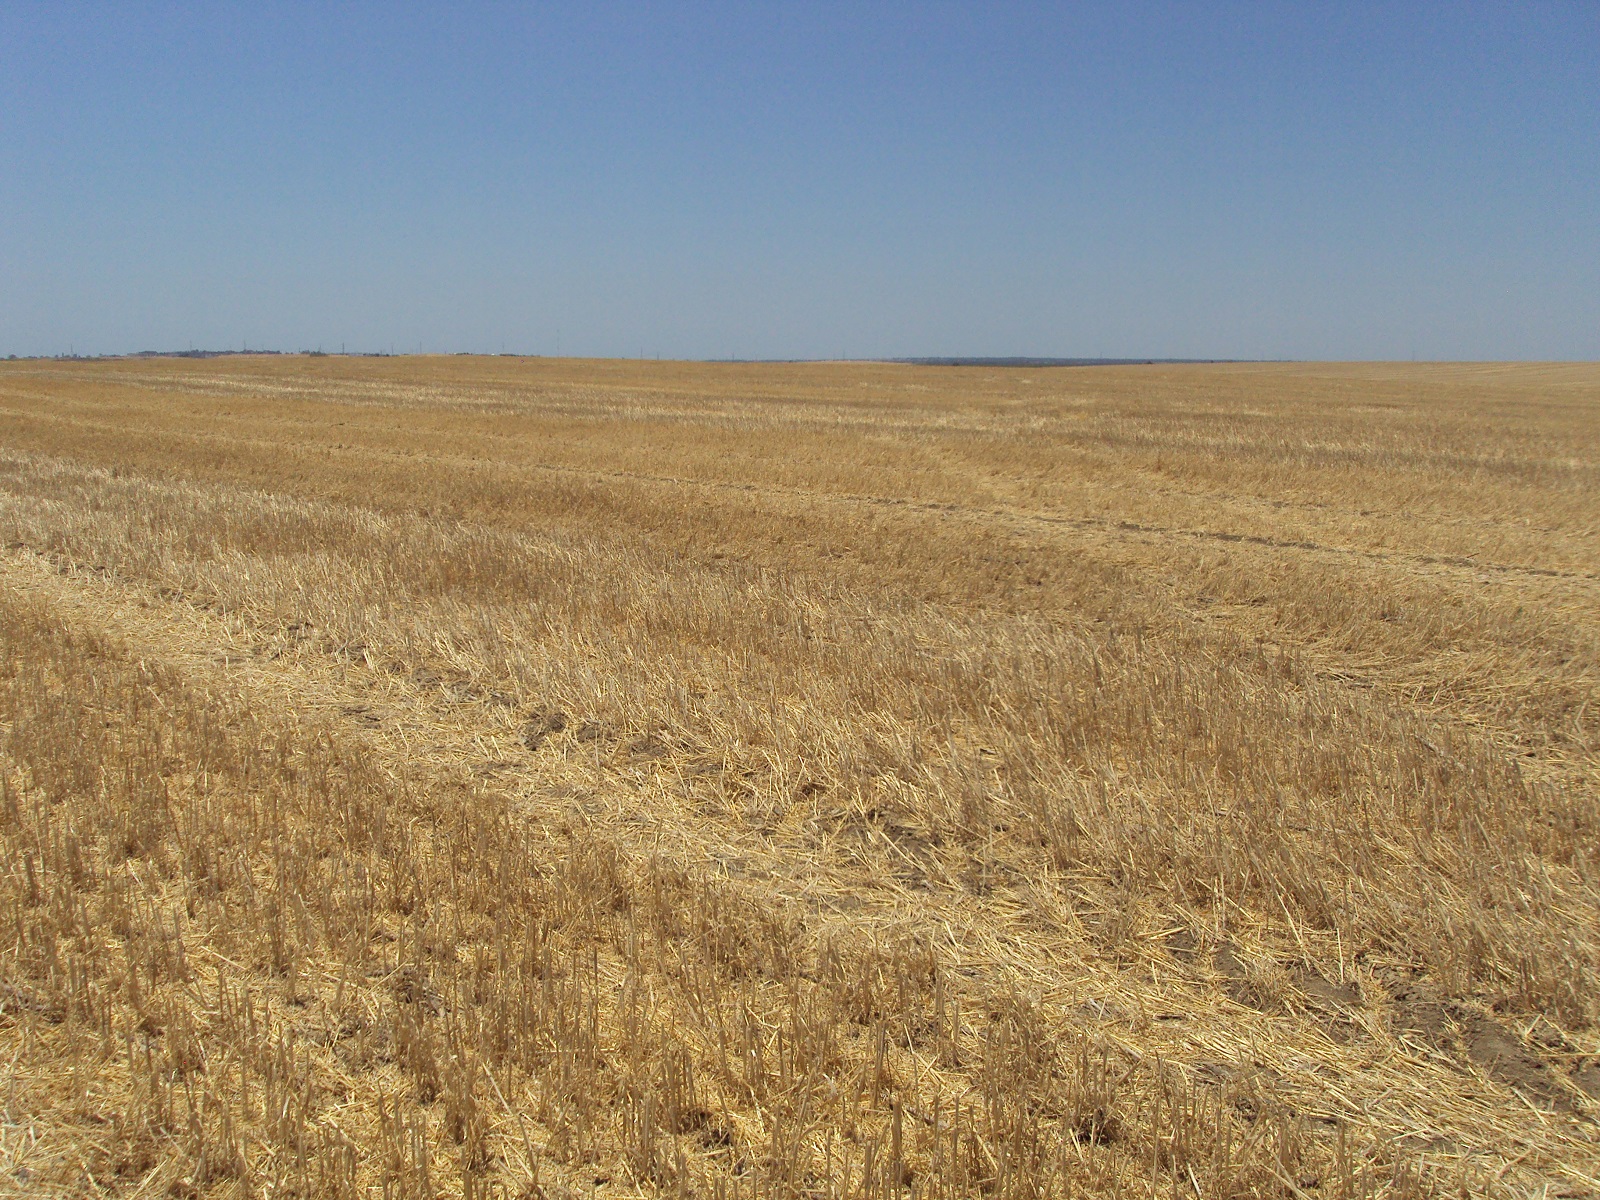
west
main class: Cropland
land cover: Durum wheat
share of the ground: > 75 %
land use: Agriculture (excluding fallow land and kitchen gardens)
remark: Harvested field
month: June
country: ES
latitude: 37.3333
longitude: -6.8893
